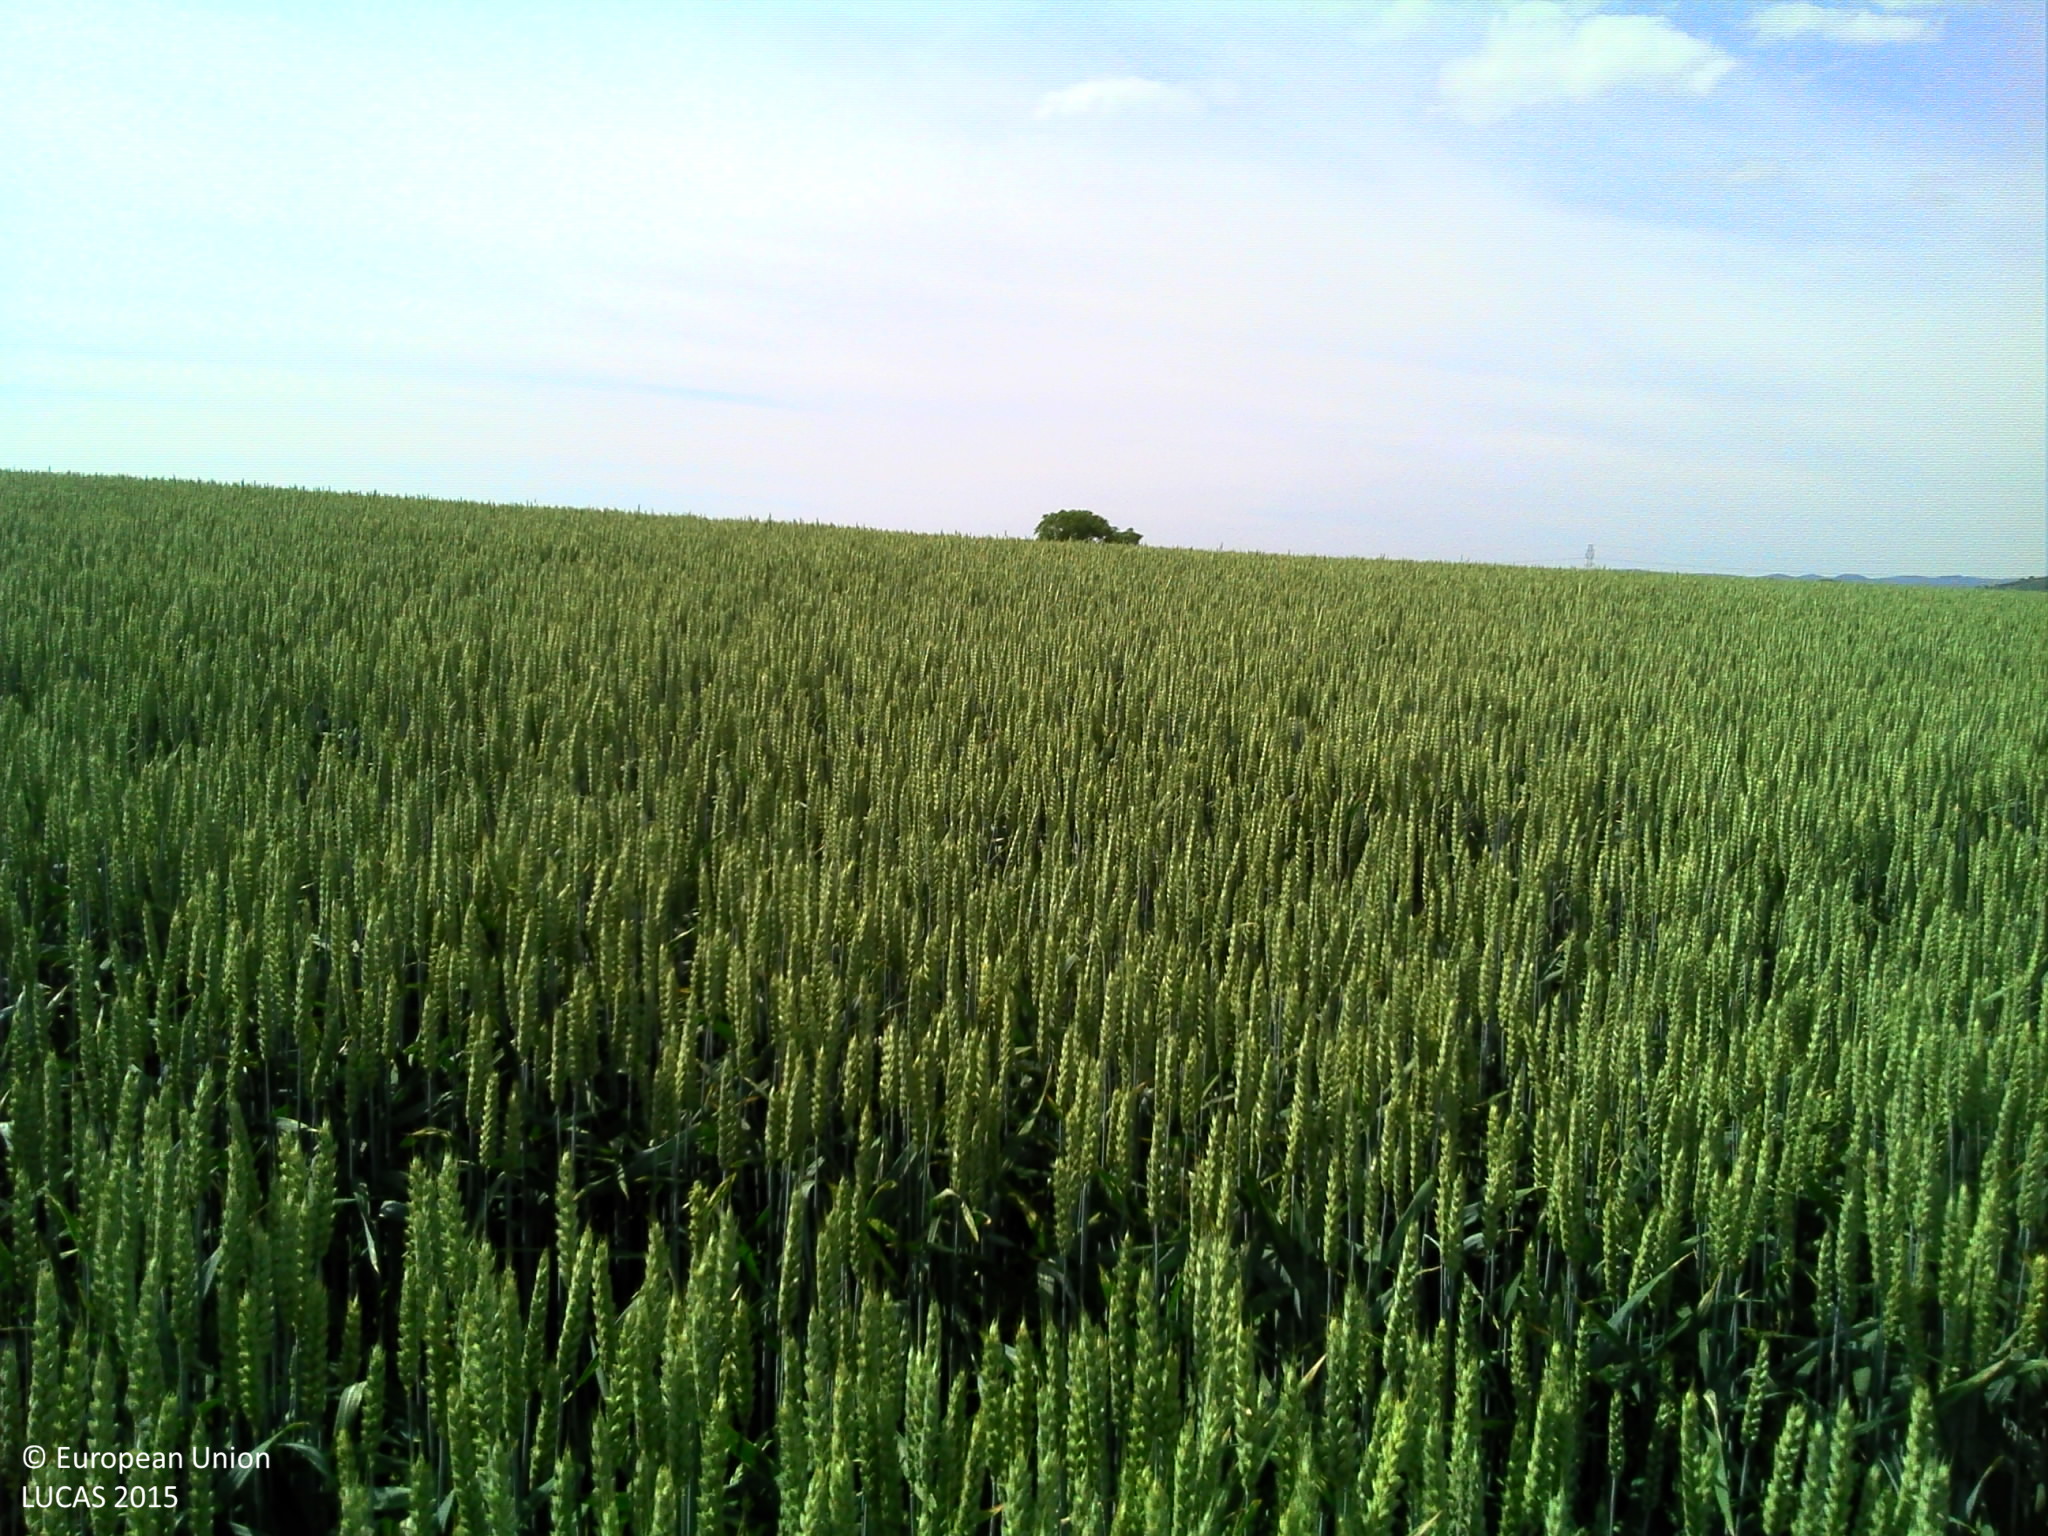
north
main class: Cropland
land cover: Common wheat
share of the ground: > 75 %
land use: Agriculture (excluding fallow land and kitchen gardens)
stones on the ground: < 10 %
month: June
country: FR
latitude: 48.7721
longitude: 7.5379
